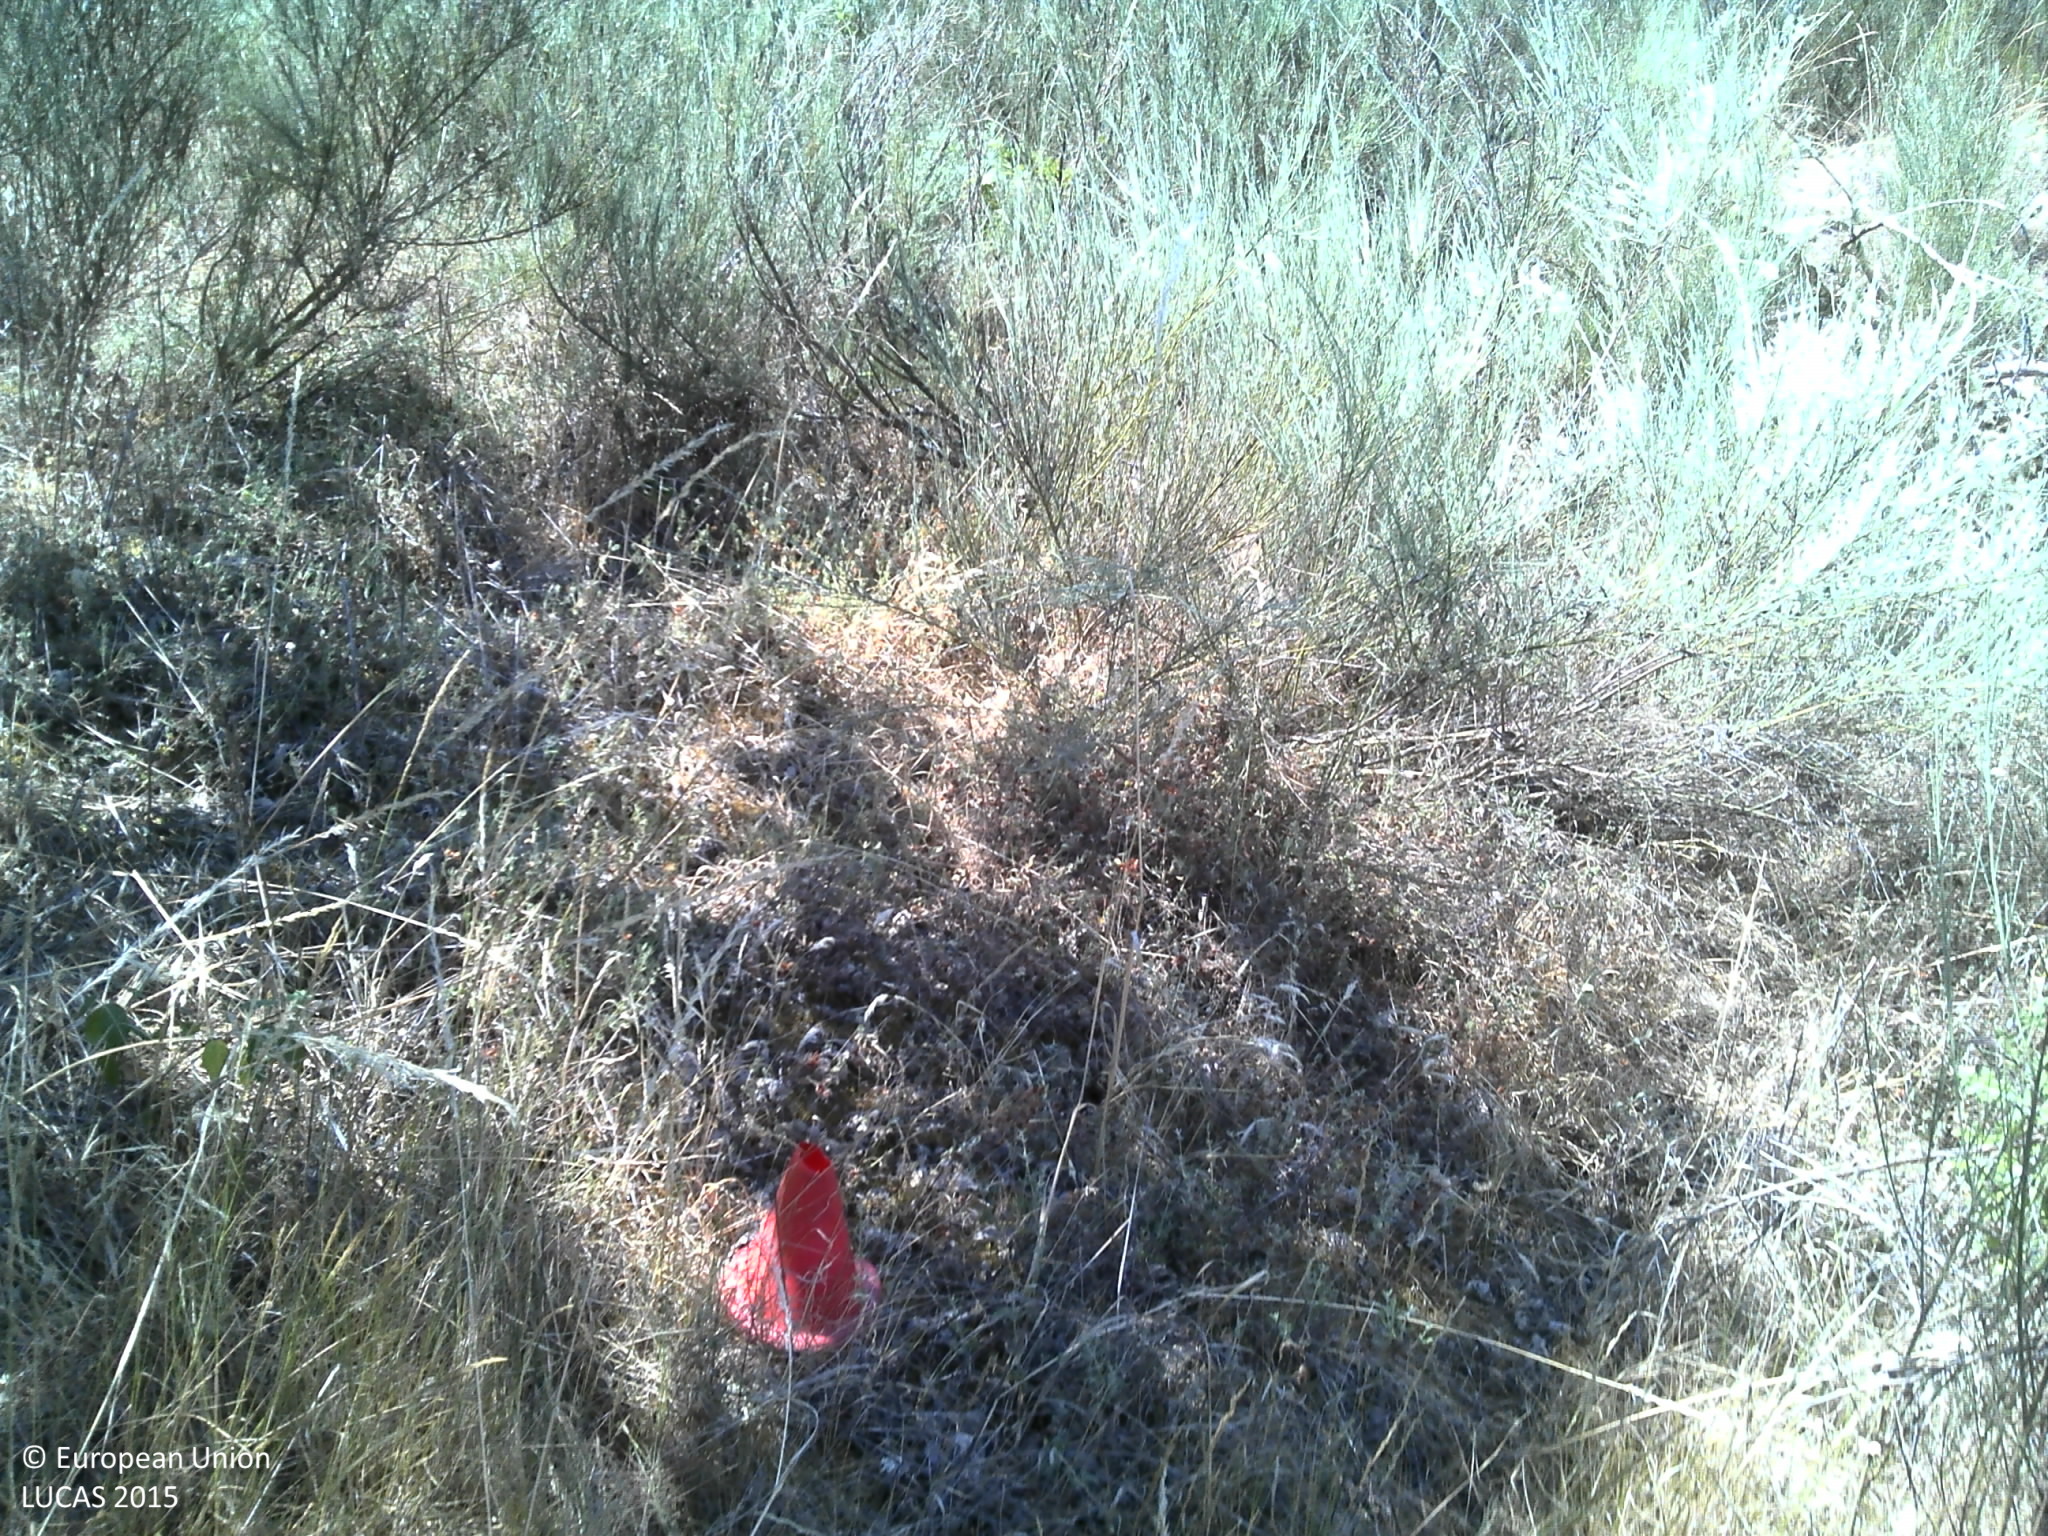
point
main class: Shrubland
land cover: Shrubland without tree cover
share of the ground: > 75 %
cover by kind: shrubs 90 %, herbaceous plants 5 %, unconsolidated bare surface 5 %
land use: Semi-natural and natural areas not in use
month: July
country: PT
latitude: 41.7835
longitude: -7.7905
